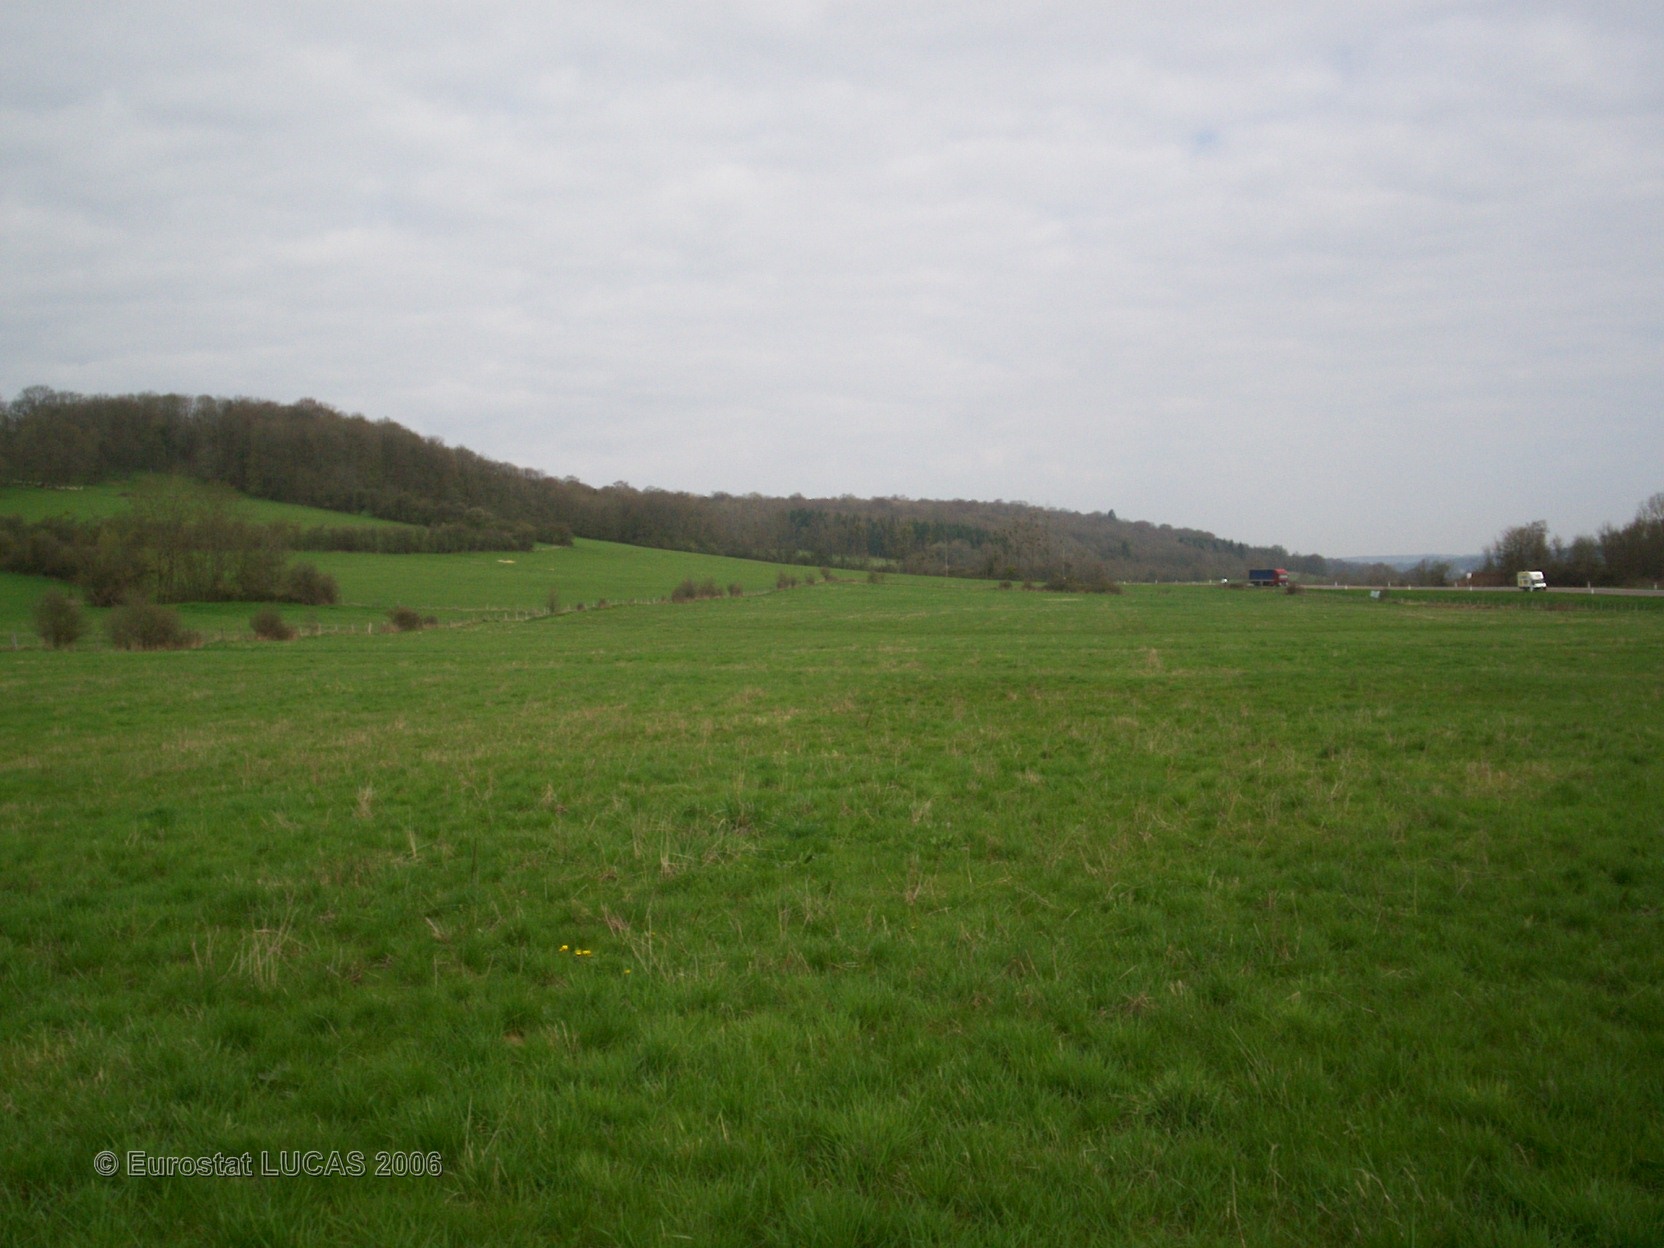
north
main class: Grassland
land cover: Grassland without tree/shrub cover
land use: Agriculture (excluding fallow land and kitchen gardens)
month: April
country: FR
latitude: 47.9599
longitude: 5.2722
